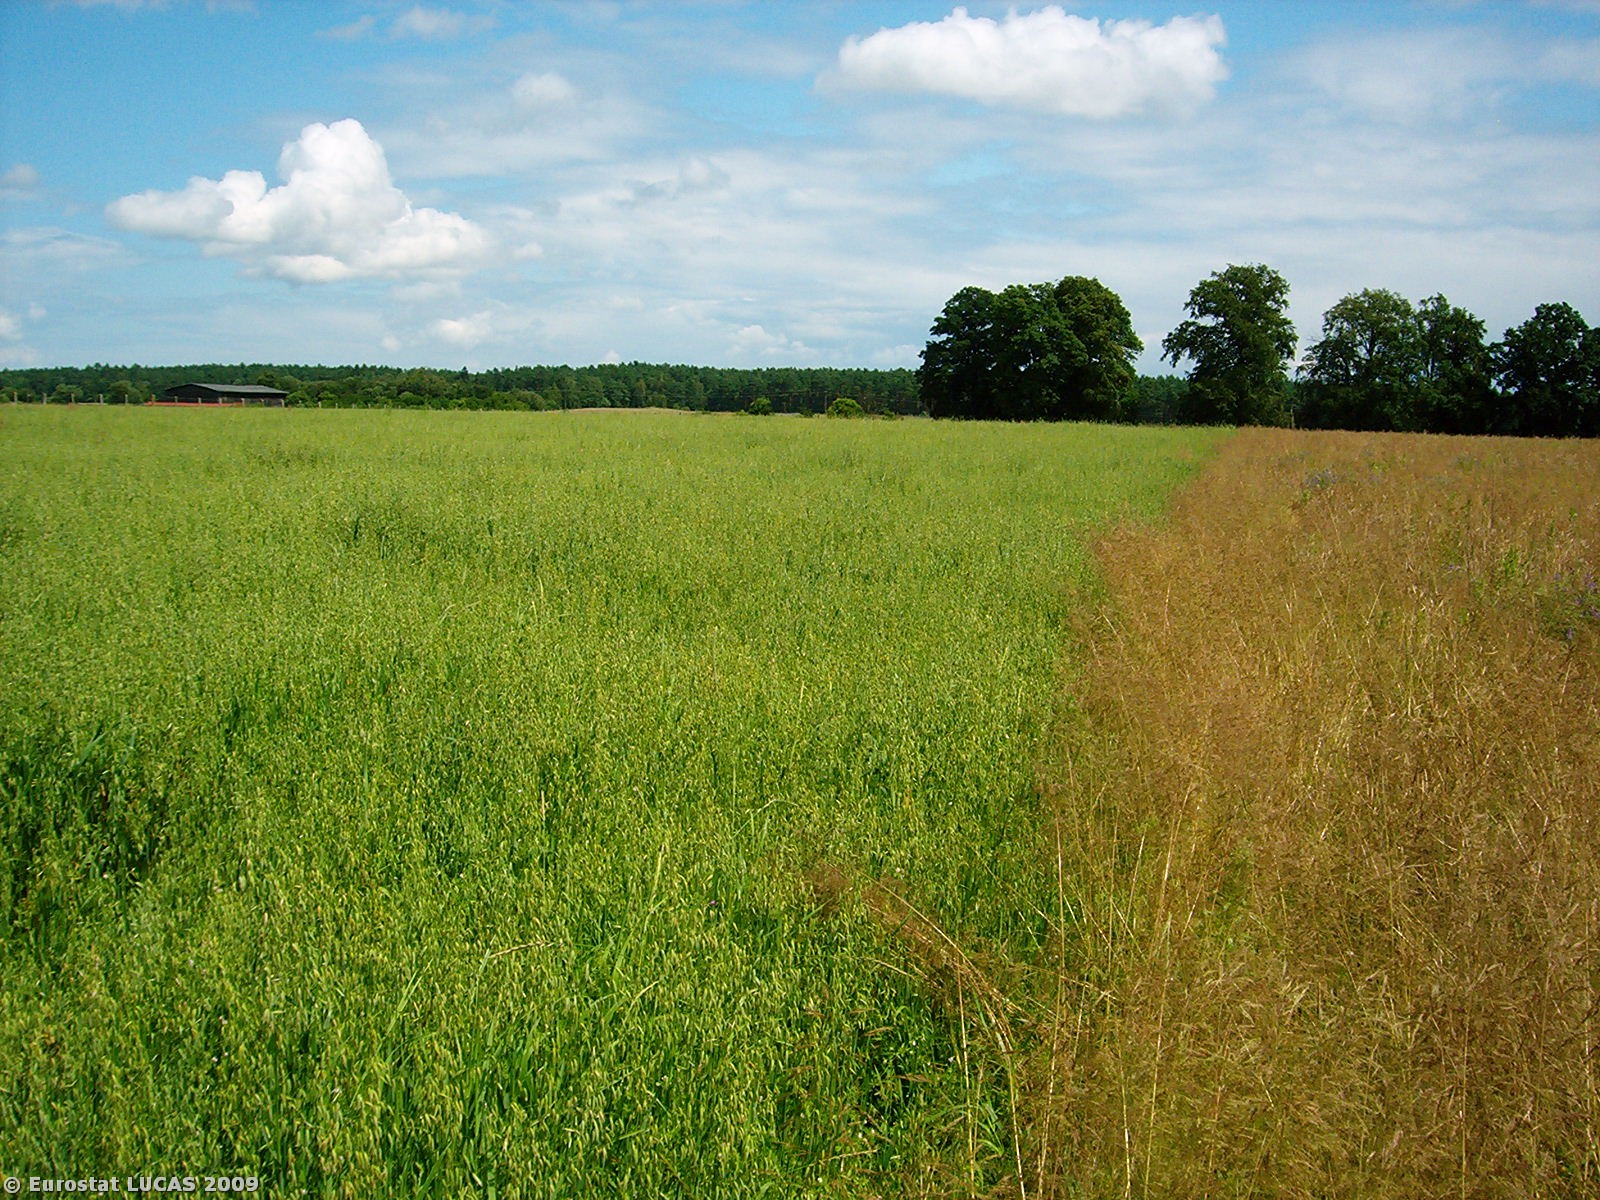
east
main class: Cropland
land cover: Oats
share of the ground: > 75 %
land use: Agriculture (excluding fallow land and kitchen gardens)
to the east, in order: Oats; Grass margins; Fences; Grassland without tree/shrub cover
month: July
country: PL
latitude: 52.2569
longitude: 15.3508
